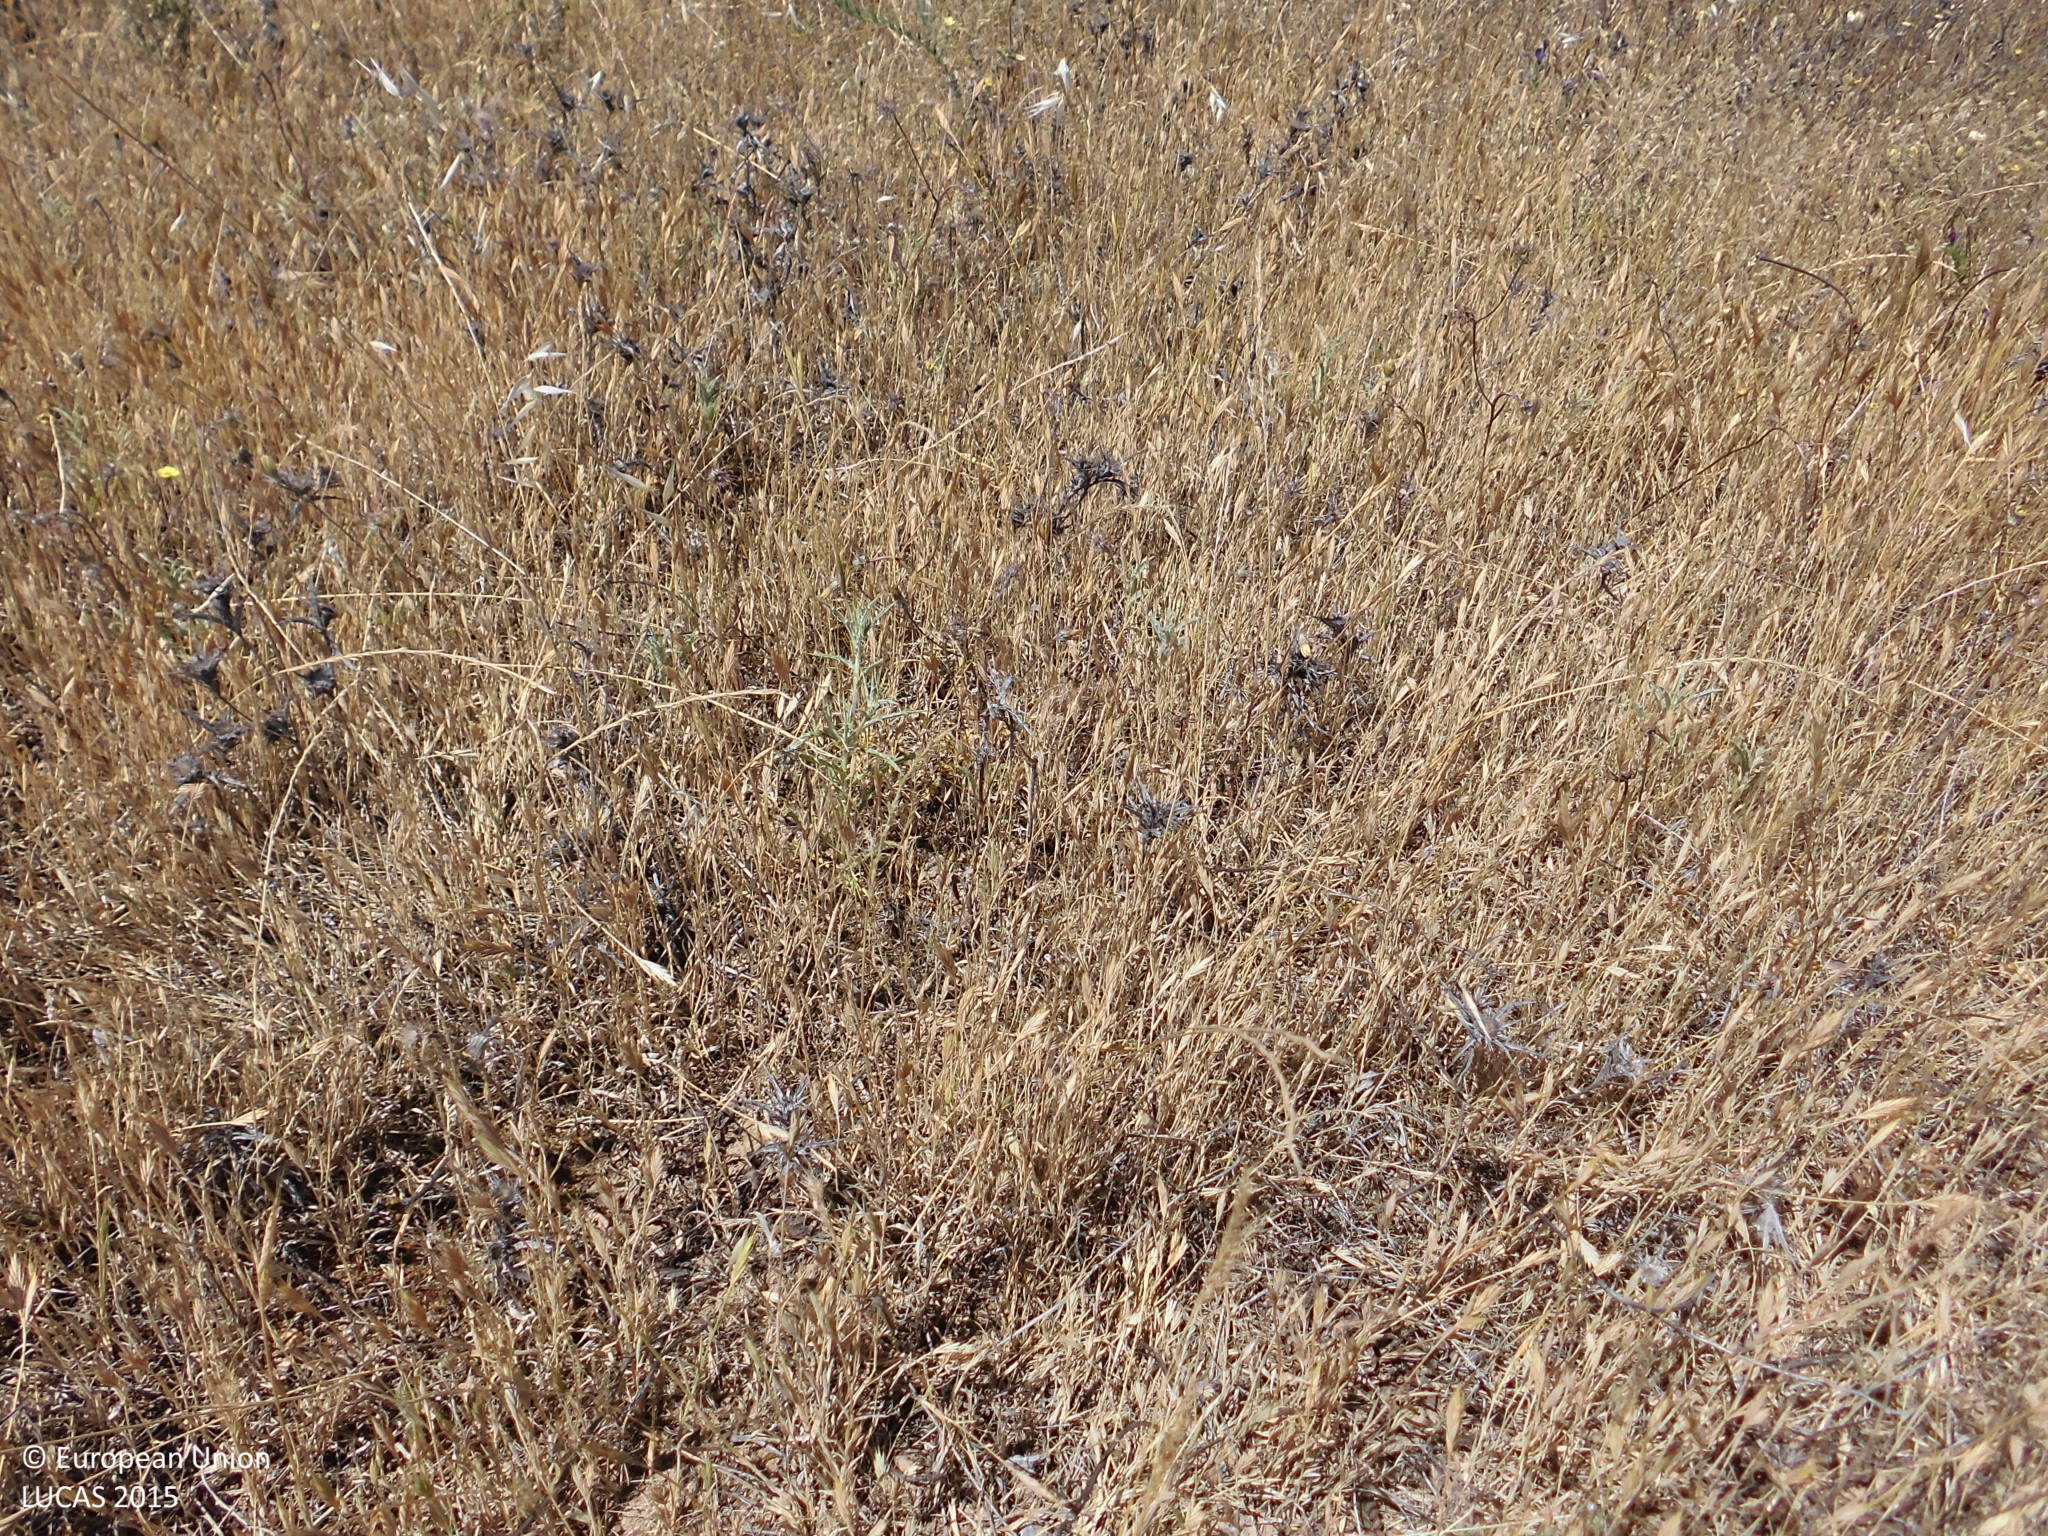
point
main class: Woodland
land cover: Broadleaved woodland
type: broadleaved evergreen forest
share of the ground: 10 - 25 %
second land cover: Grassland without tree/shrub cover
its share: > 75 %
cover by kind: herbaceous plants 90 %, broadleaved forest trees 10 %
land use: Forestry
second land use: Agriculture (excluding fallow land and kitchen gardens)
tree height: > 5 m
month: May
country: ES
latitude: 39.4131
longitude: -6.8126
